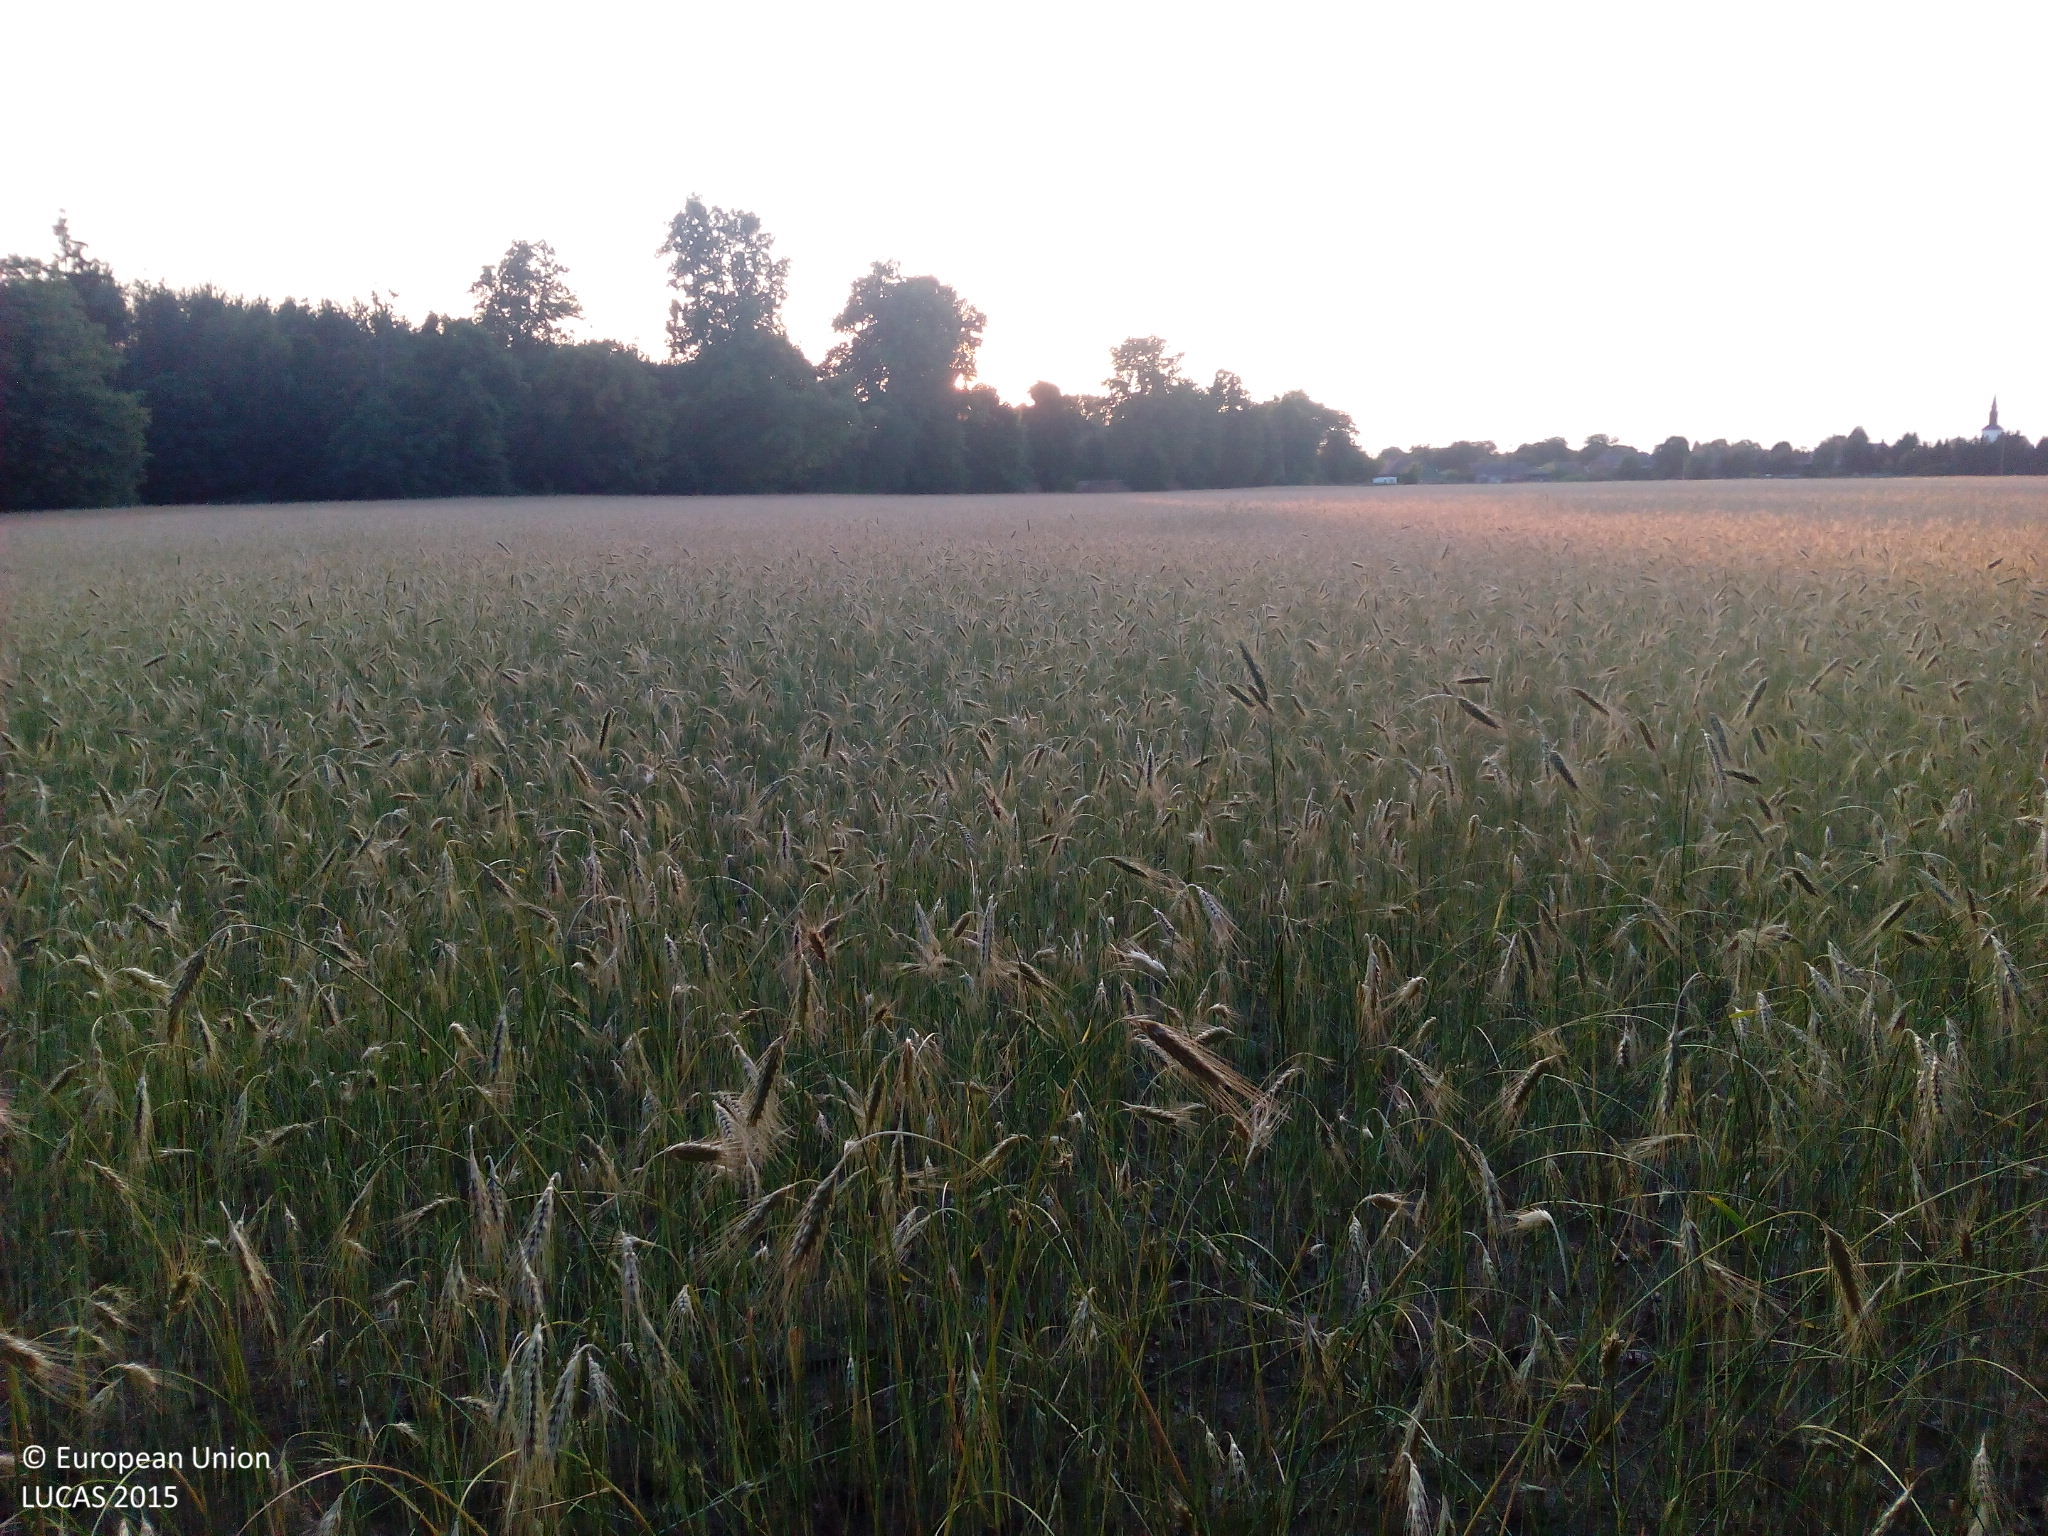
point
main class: Cropland
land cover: Rye
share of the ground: 50 - 75 %
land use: Agriculture (excluding fallow land and kitchen gardens)
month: July
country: DE
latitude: 53.5089
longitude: 14.2075
